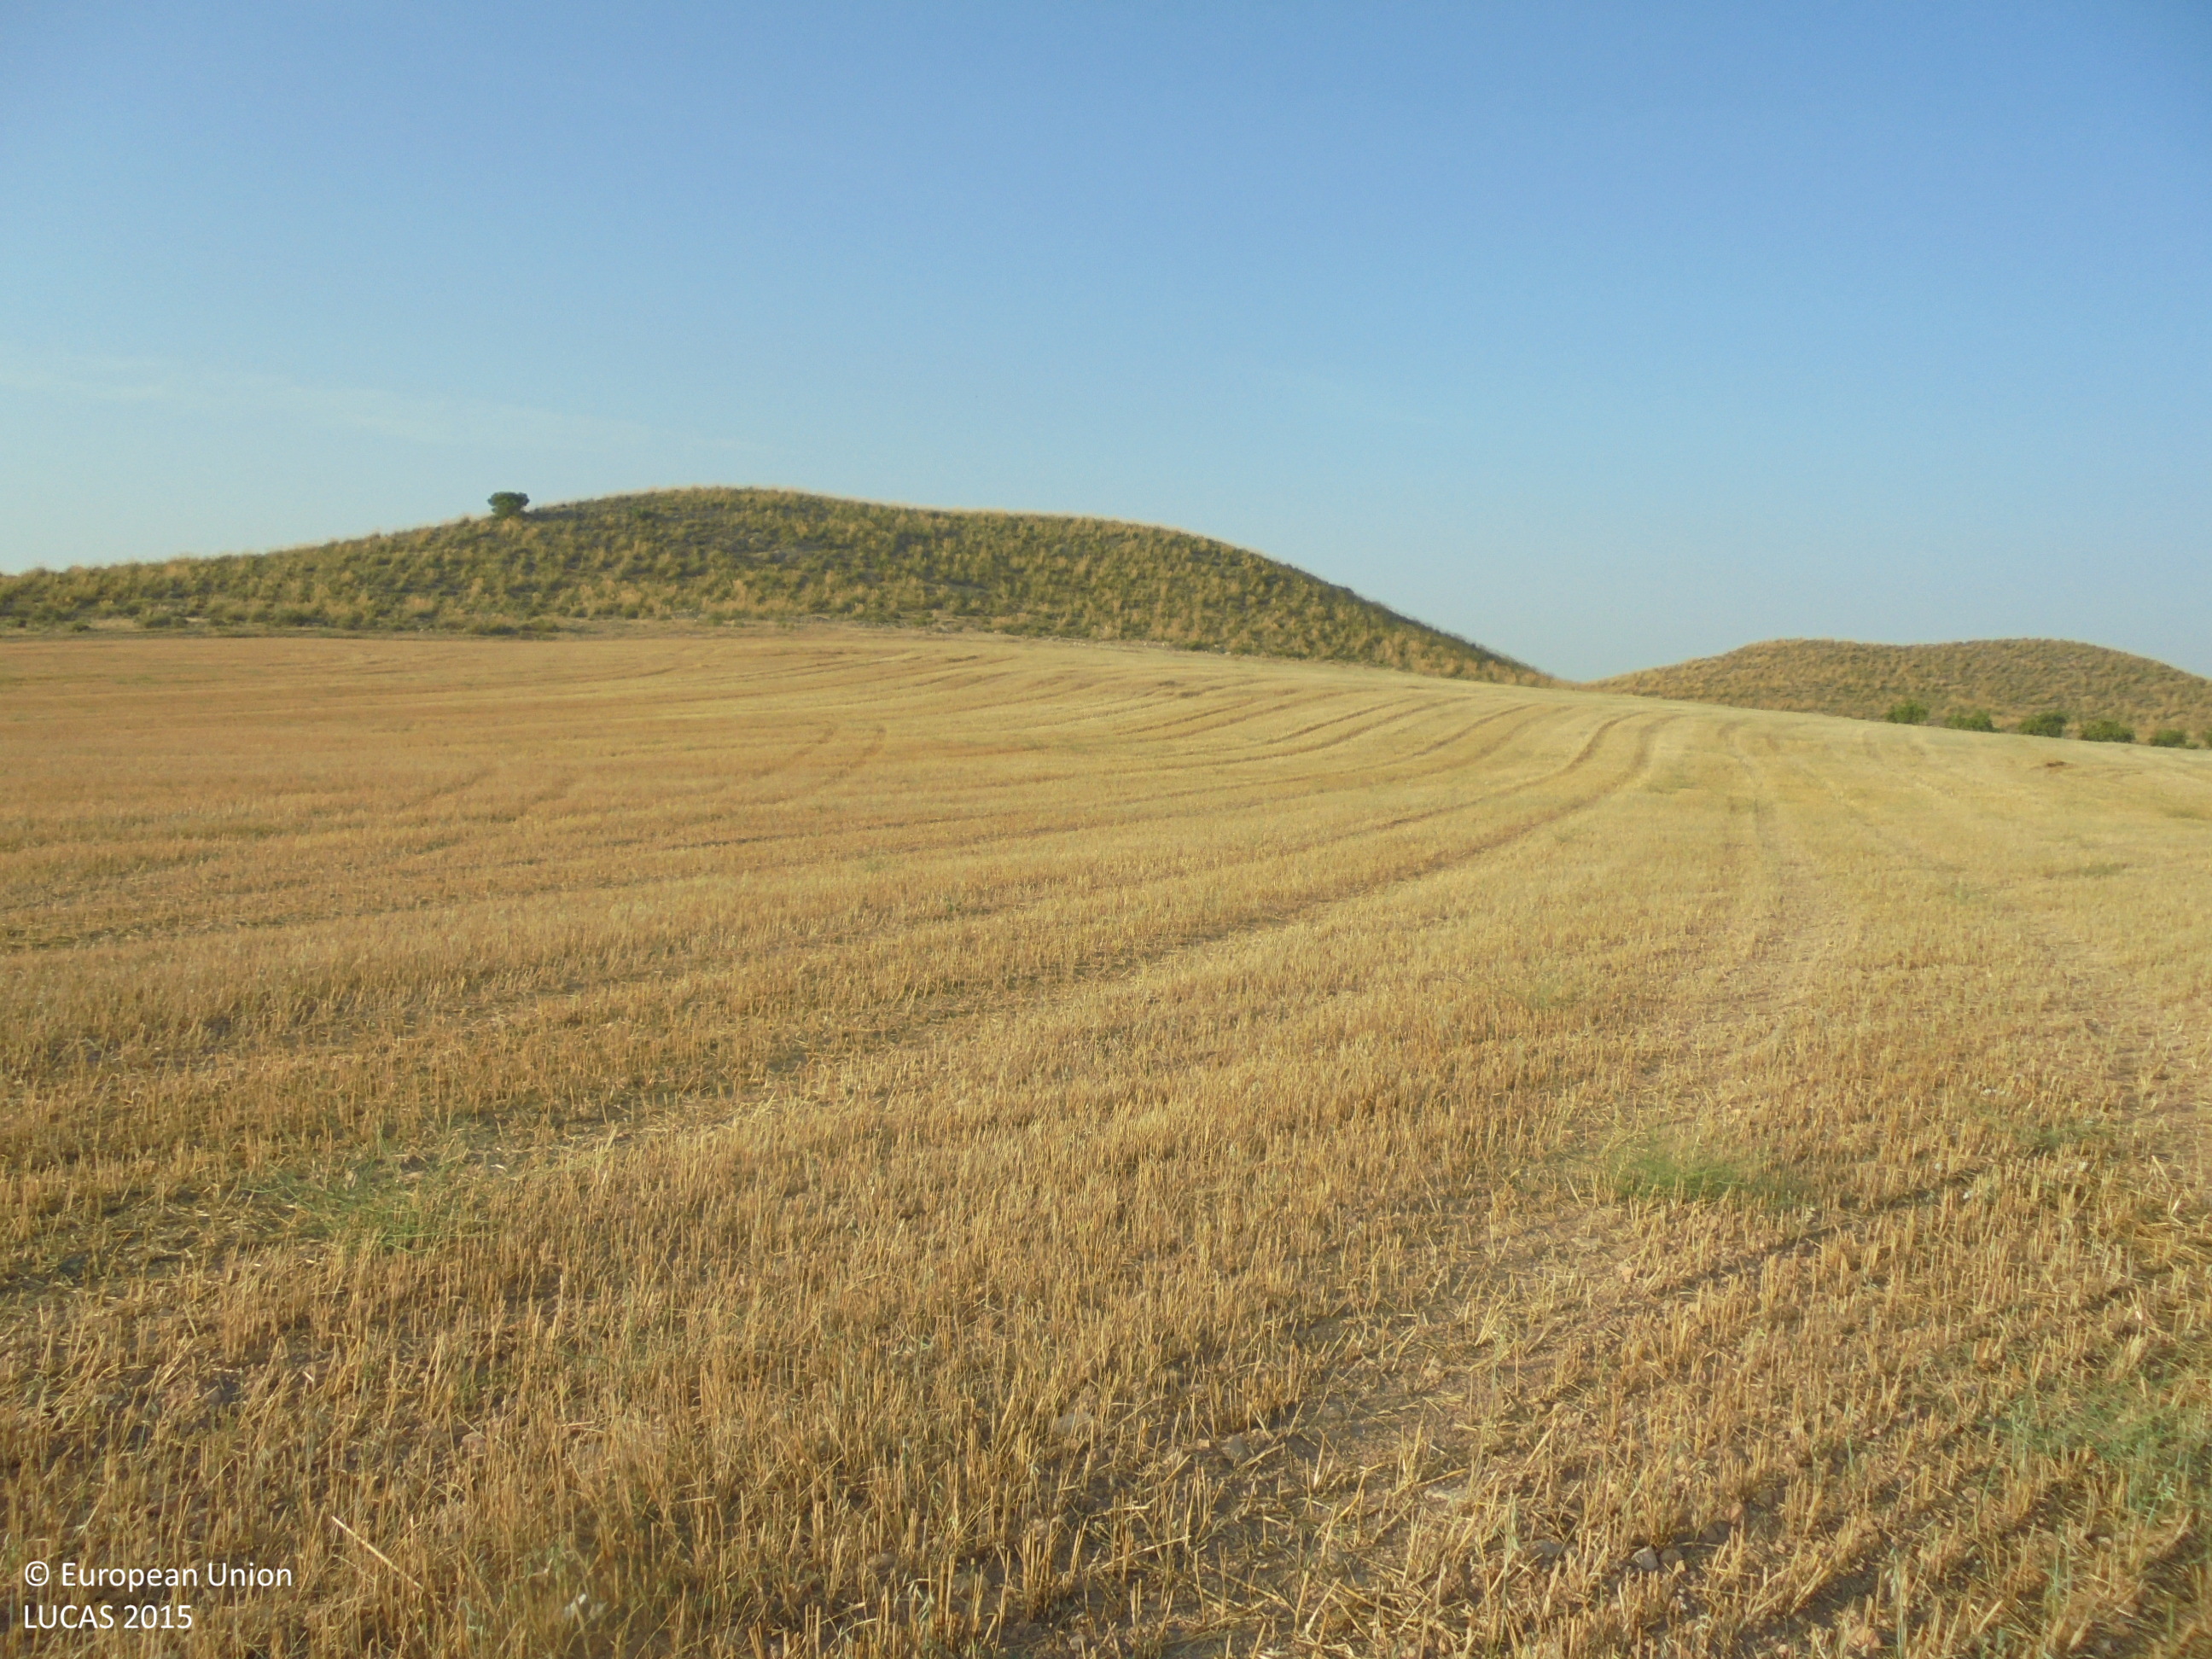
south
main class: Cropland
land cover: Oats
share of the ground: < 10 %
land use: Agriculture (excluding fallow land and kitchen gardens)
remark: Harvested field
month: July
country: ES
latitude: 38.6175
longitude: -1.6749
